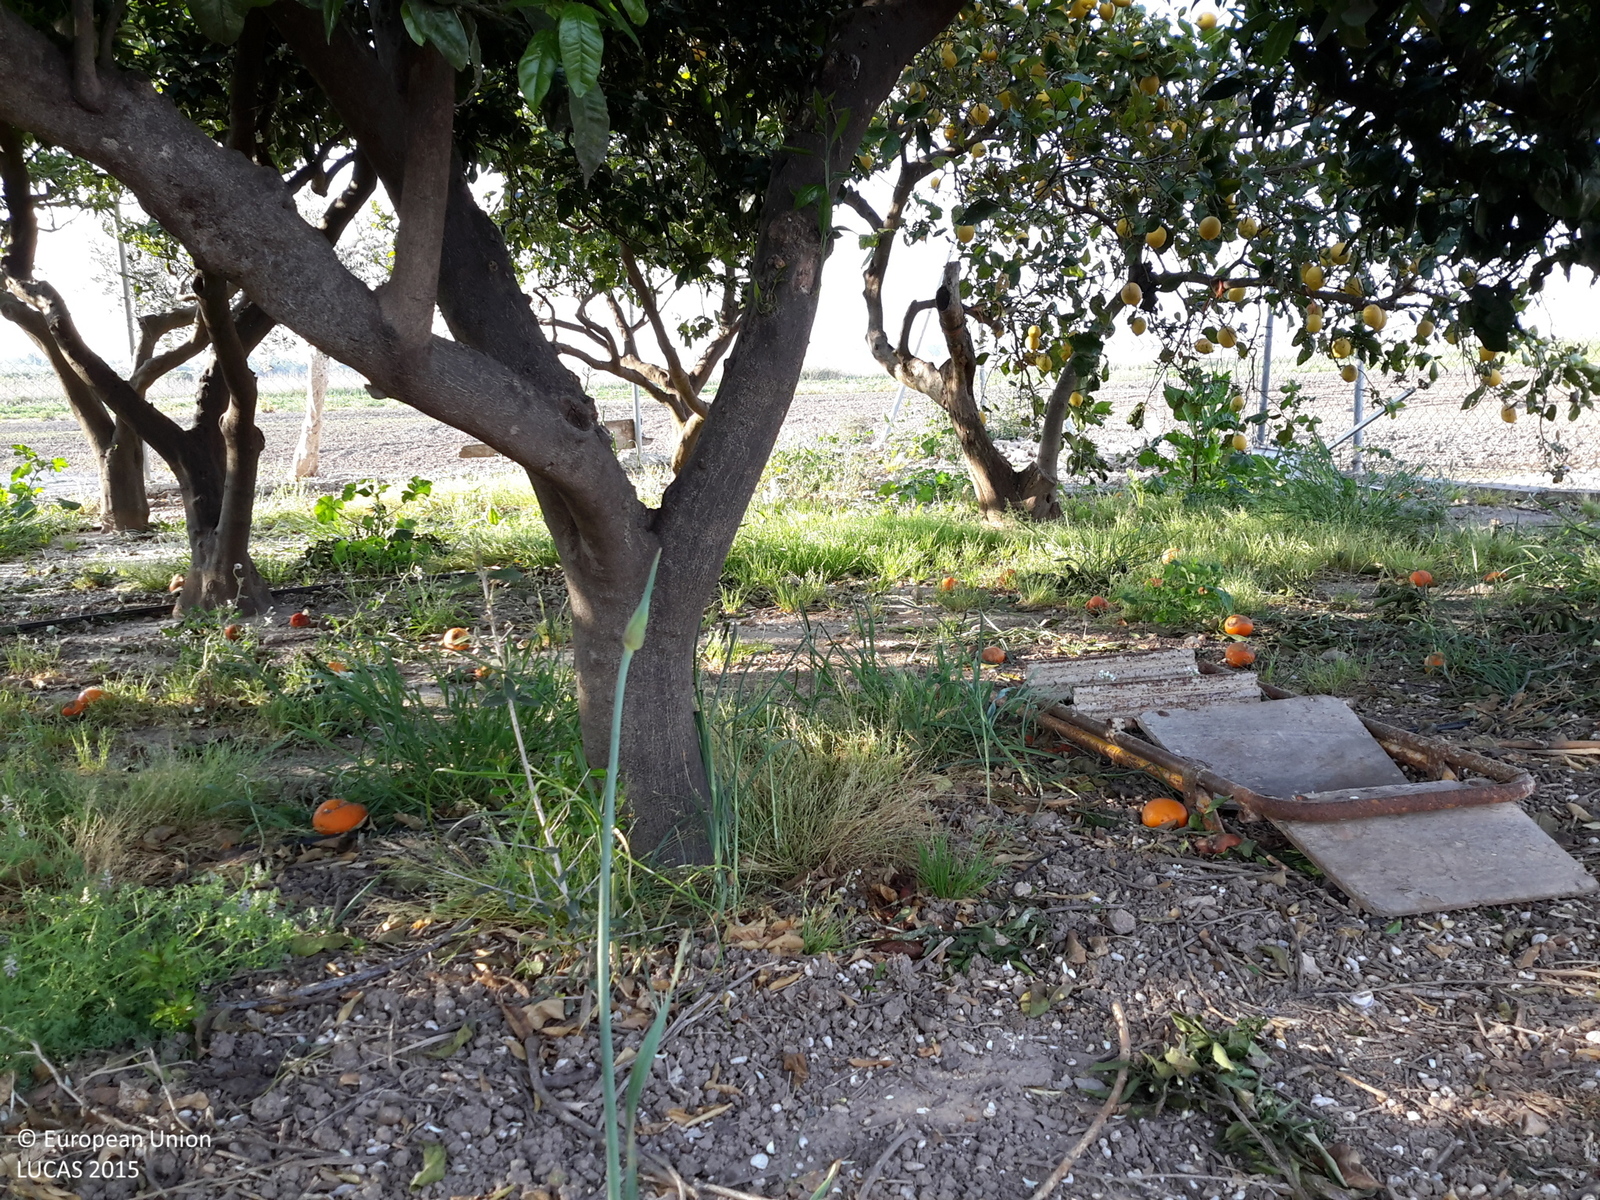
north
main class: Cropland
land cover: Oranges
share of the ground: 25 - 50 %
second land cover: Spontaneously vegetated surfaces
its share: 50 - 75 %
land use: Agriculture (excluding fallow land and kitchen gardens)
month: April
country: ES
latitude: 40.6517
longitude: 0.5935
